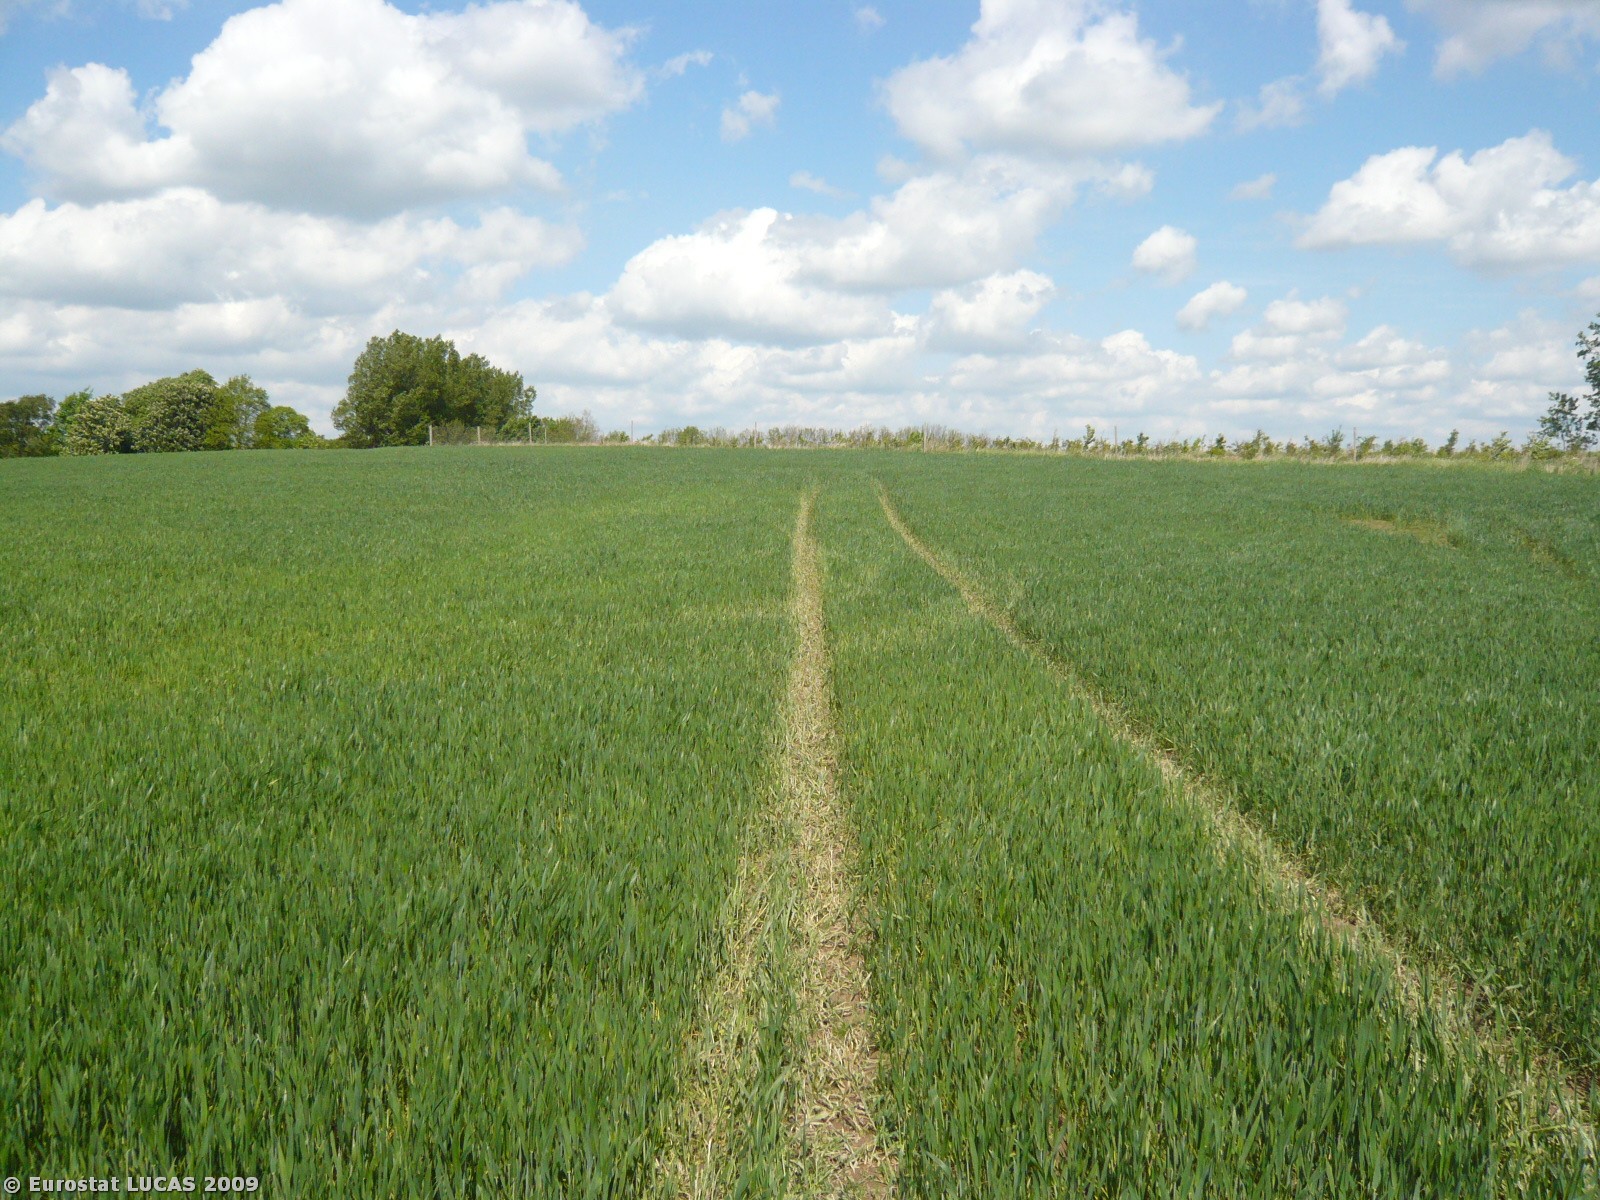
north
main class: Cropland
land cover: Common wheat
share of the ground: > 75 %
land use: Agriculture (excluding fallow land and kitchen gardens)
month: May
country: DK
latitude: 55.3979
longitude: 12.0669
